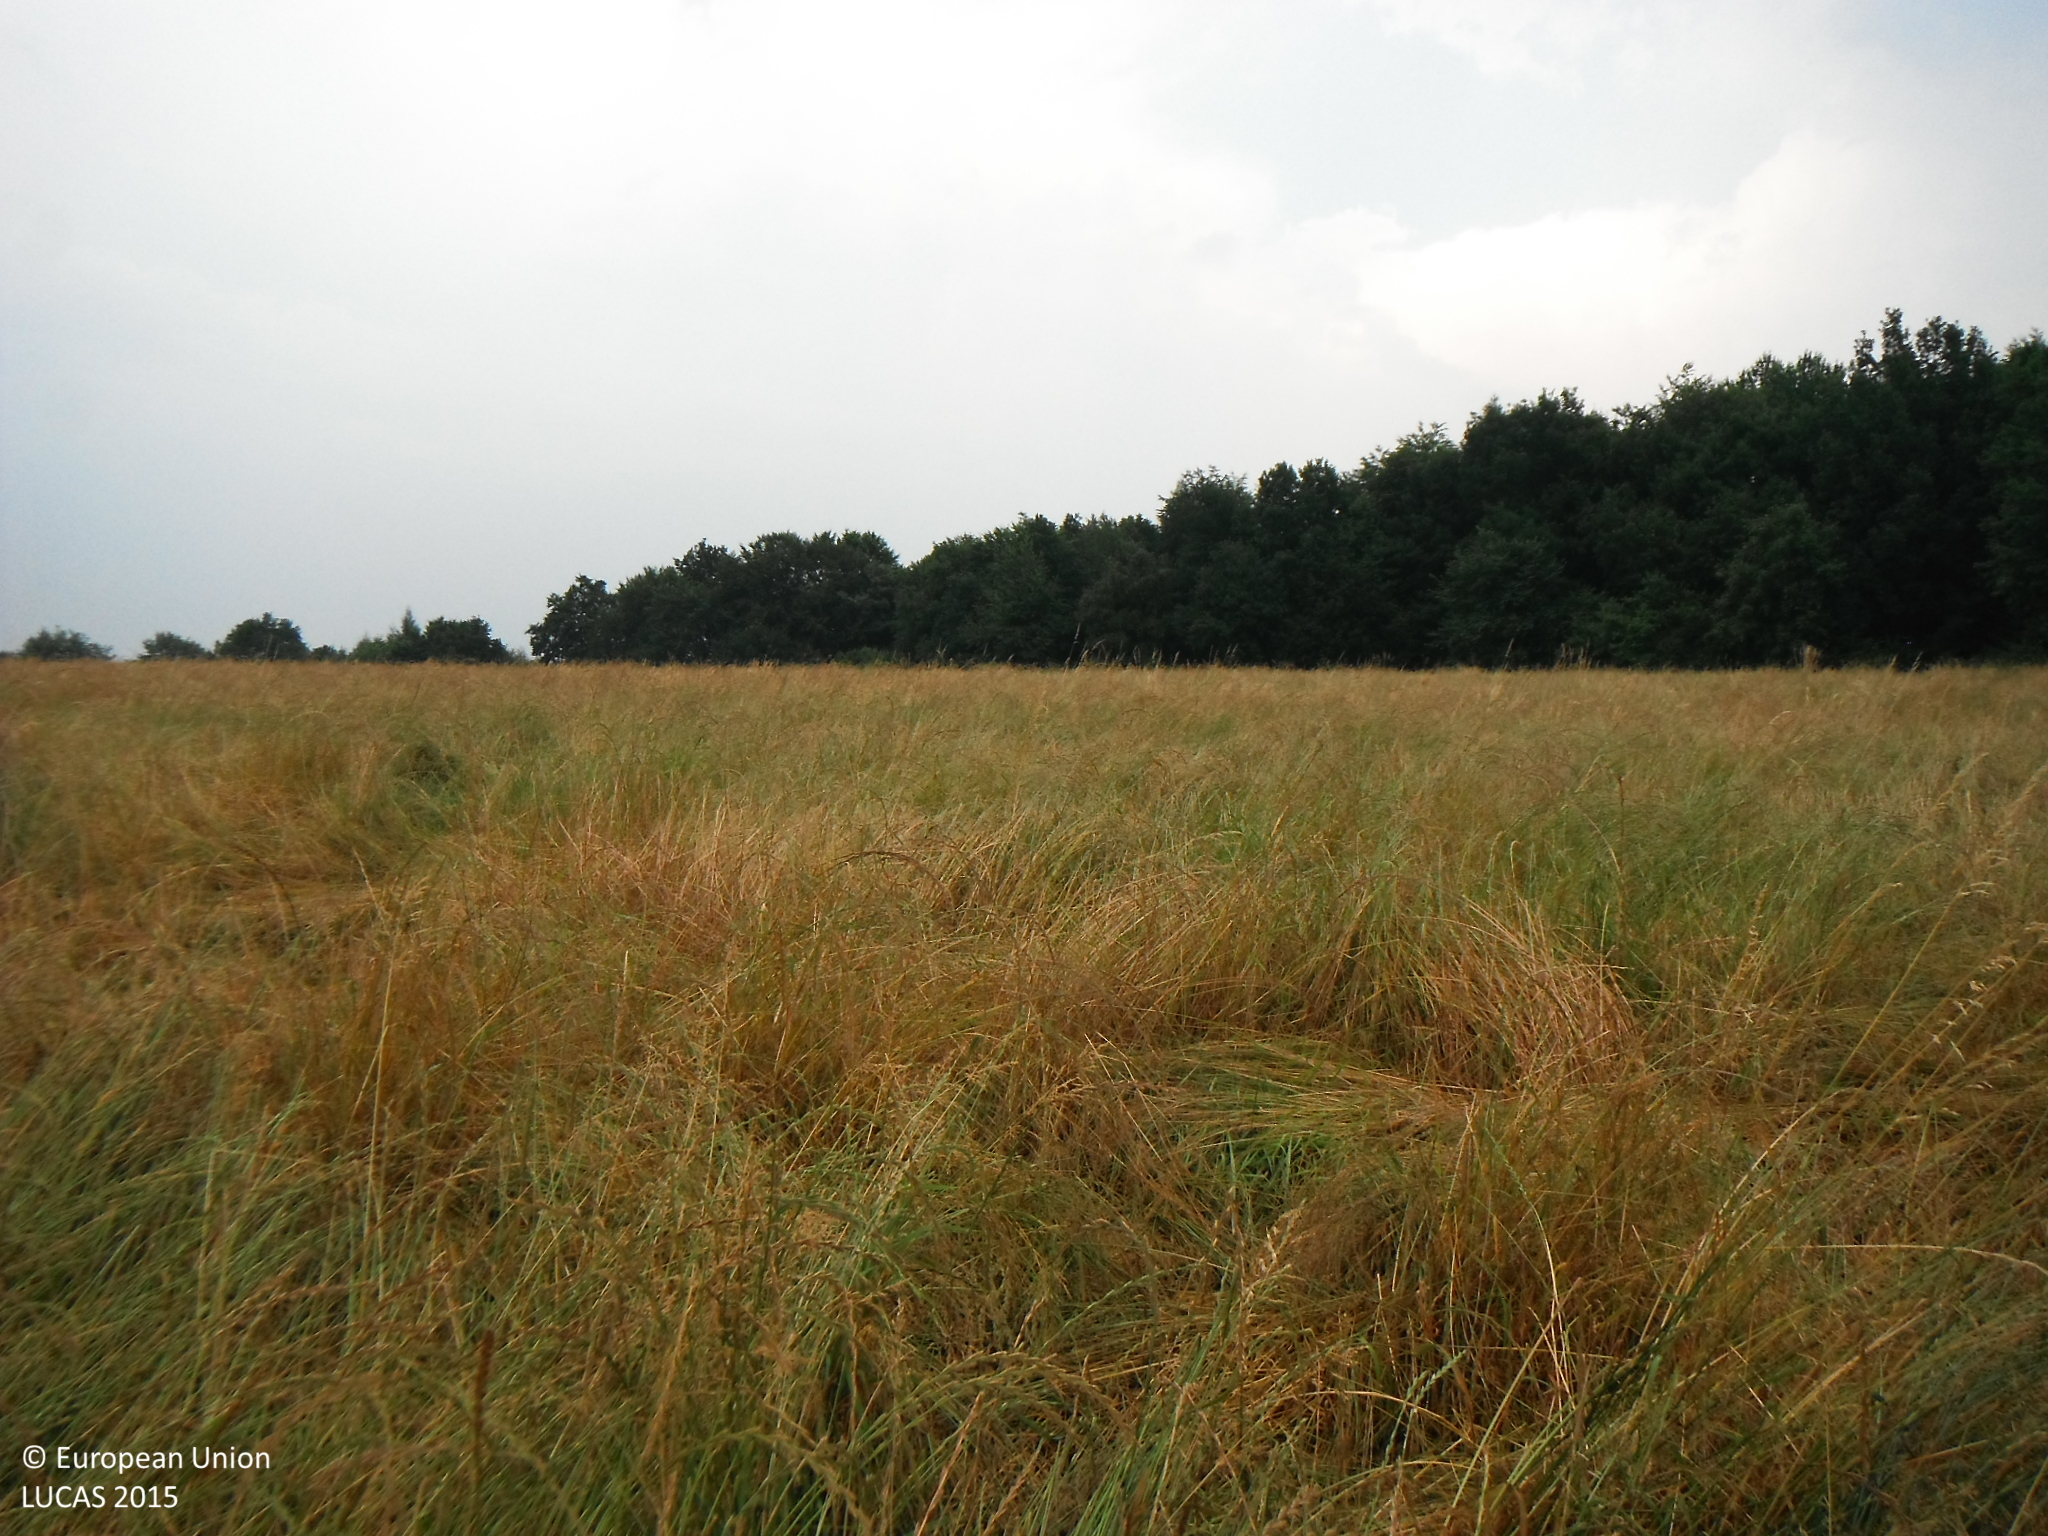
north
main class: Grassland
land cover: Grassland without tree/shrub cover
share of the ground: > 75 %
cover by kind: herbaceous plants 100 %
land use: Agriculture (excluding fallow land and kitchen gardens)
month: July
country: SK
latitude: 49.2928
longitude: 21.3076
